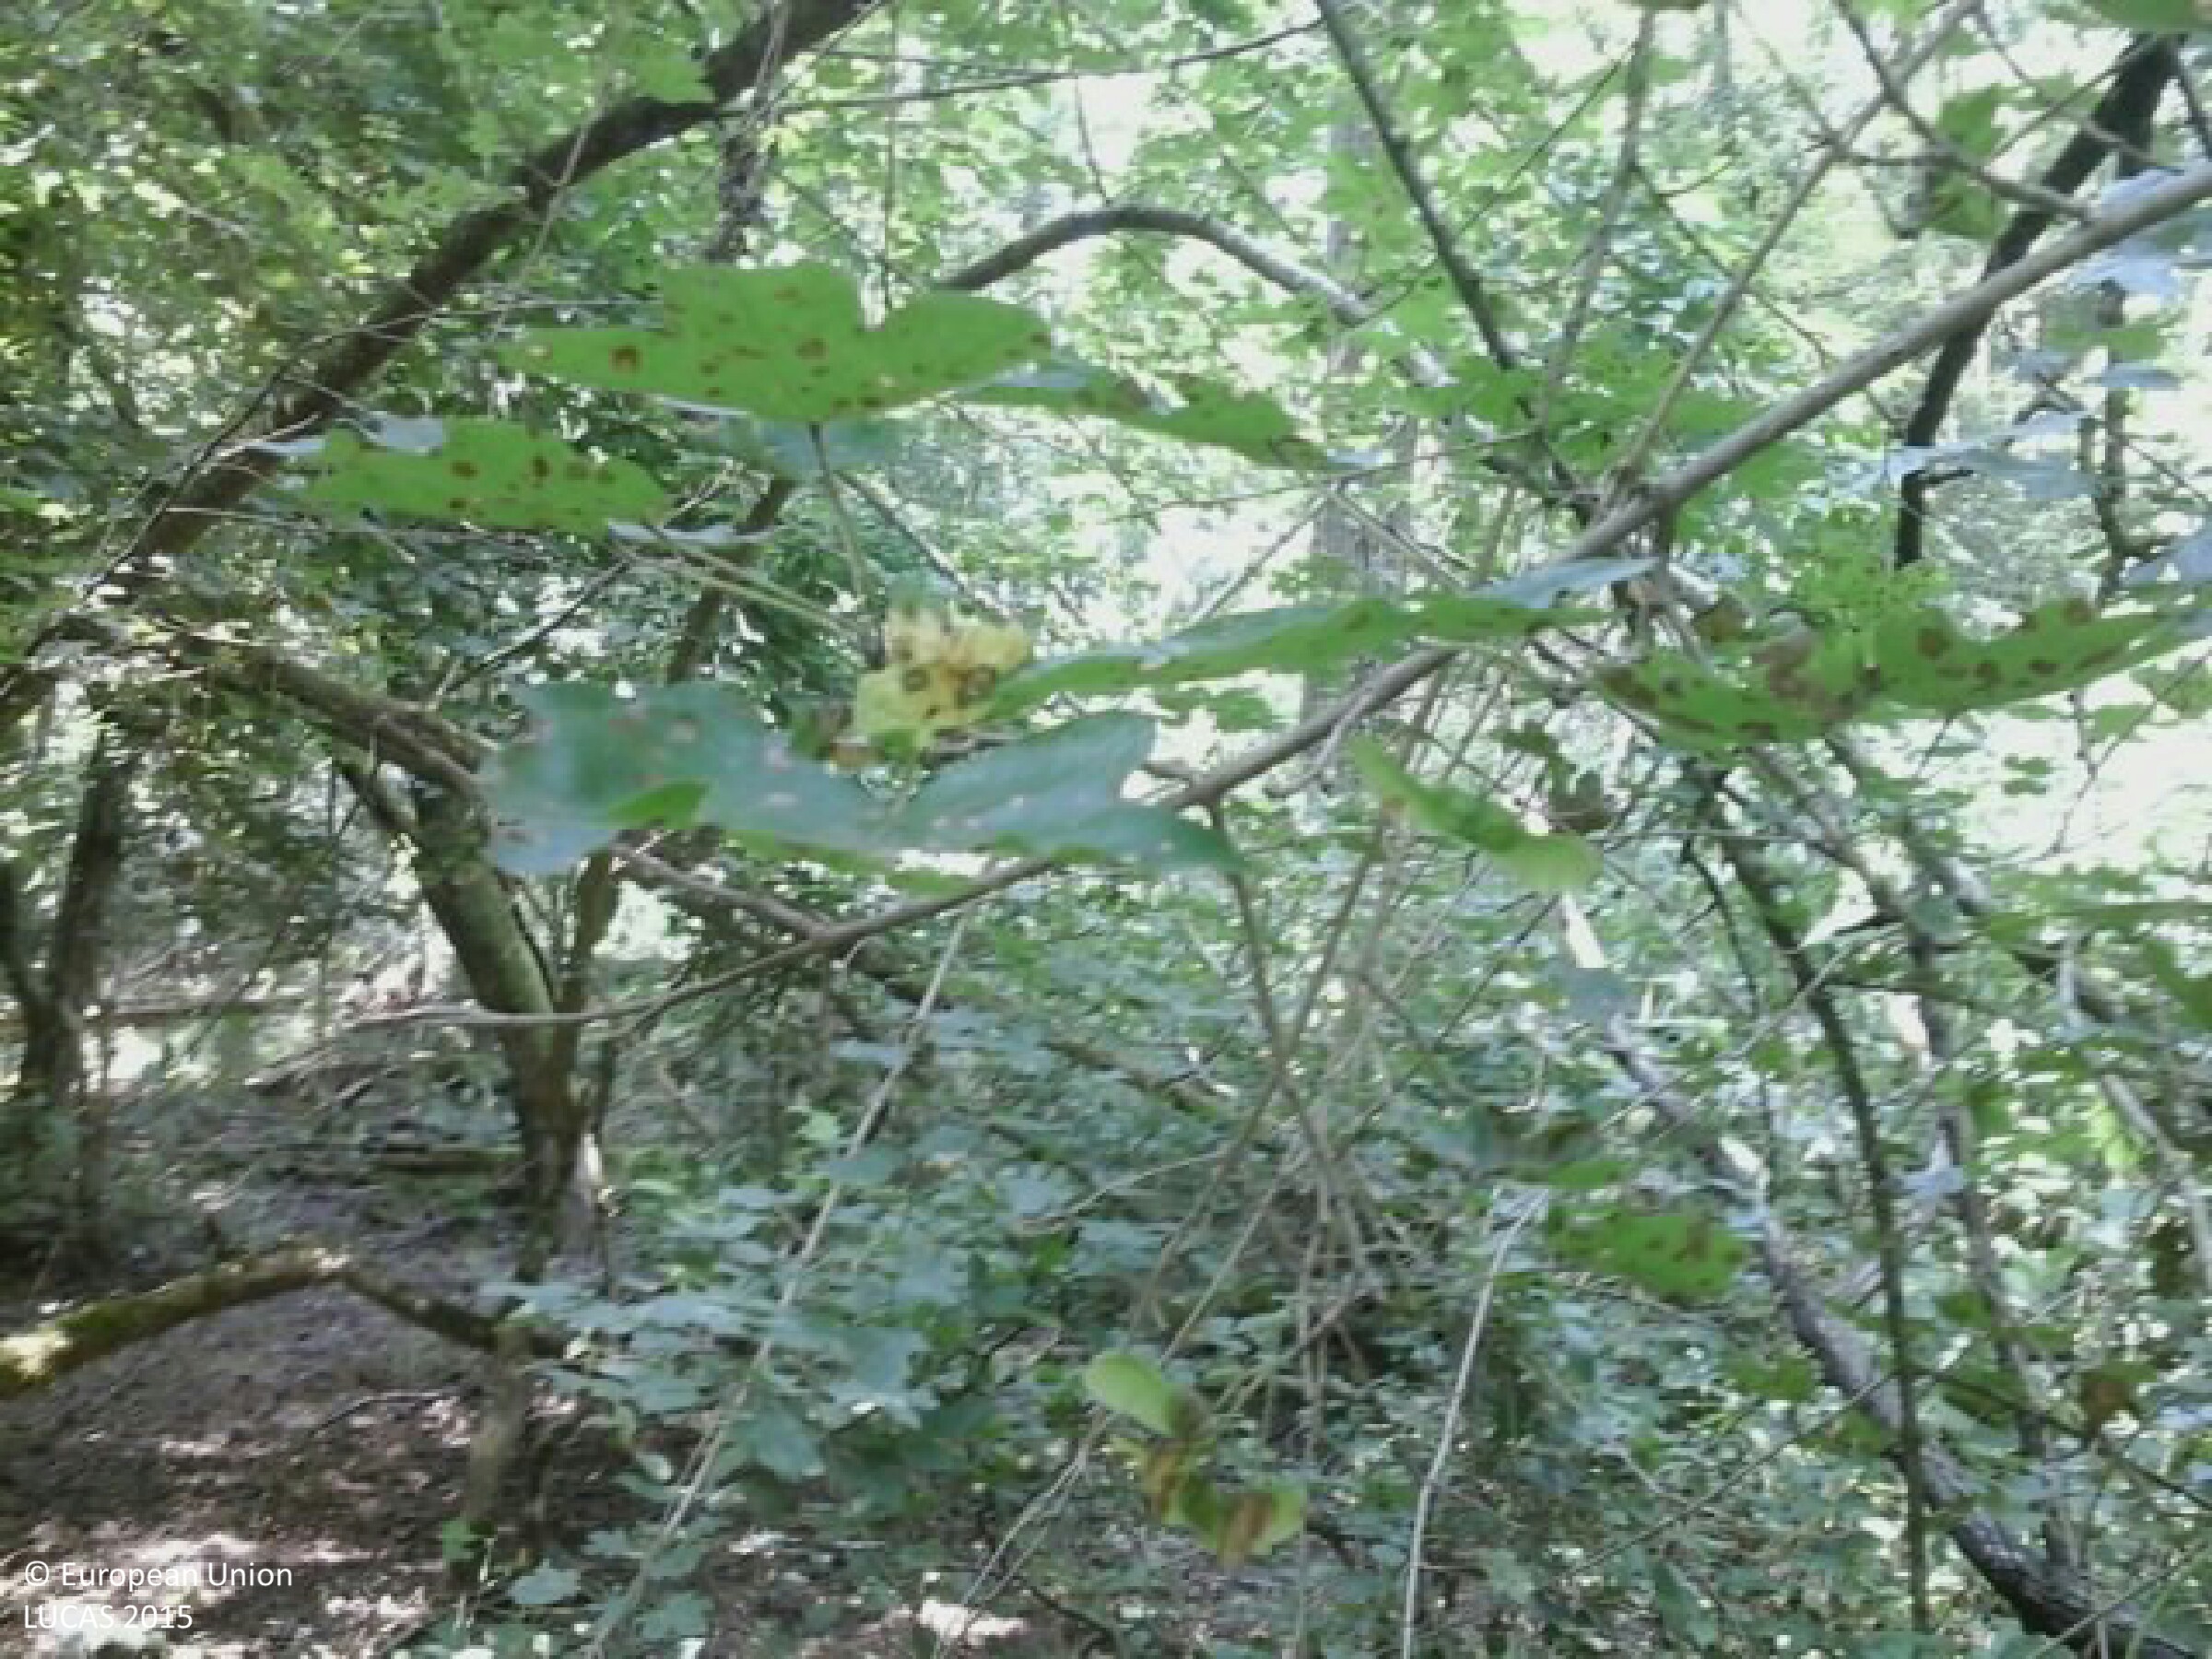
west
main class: Woodland
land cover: Broadleaved woodland
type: mesophytic deciduous forest
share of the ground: > 75 %
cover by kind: broadleaved forest trees 90 %, shrubs 5 %, herbaceous plants 5 %
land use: Forestry
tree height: > 5 m
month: July
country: HU
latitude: 46.3187
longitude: 17.0285
